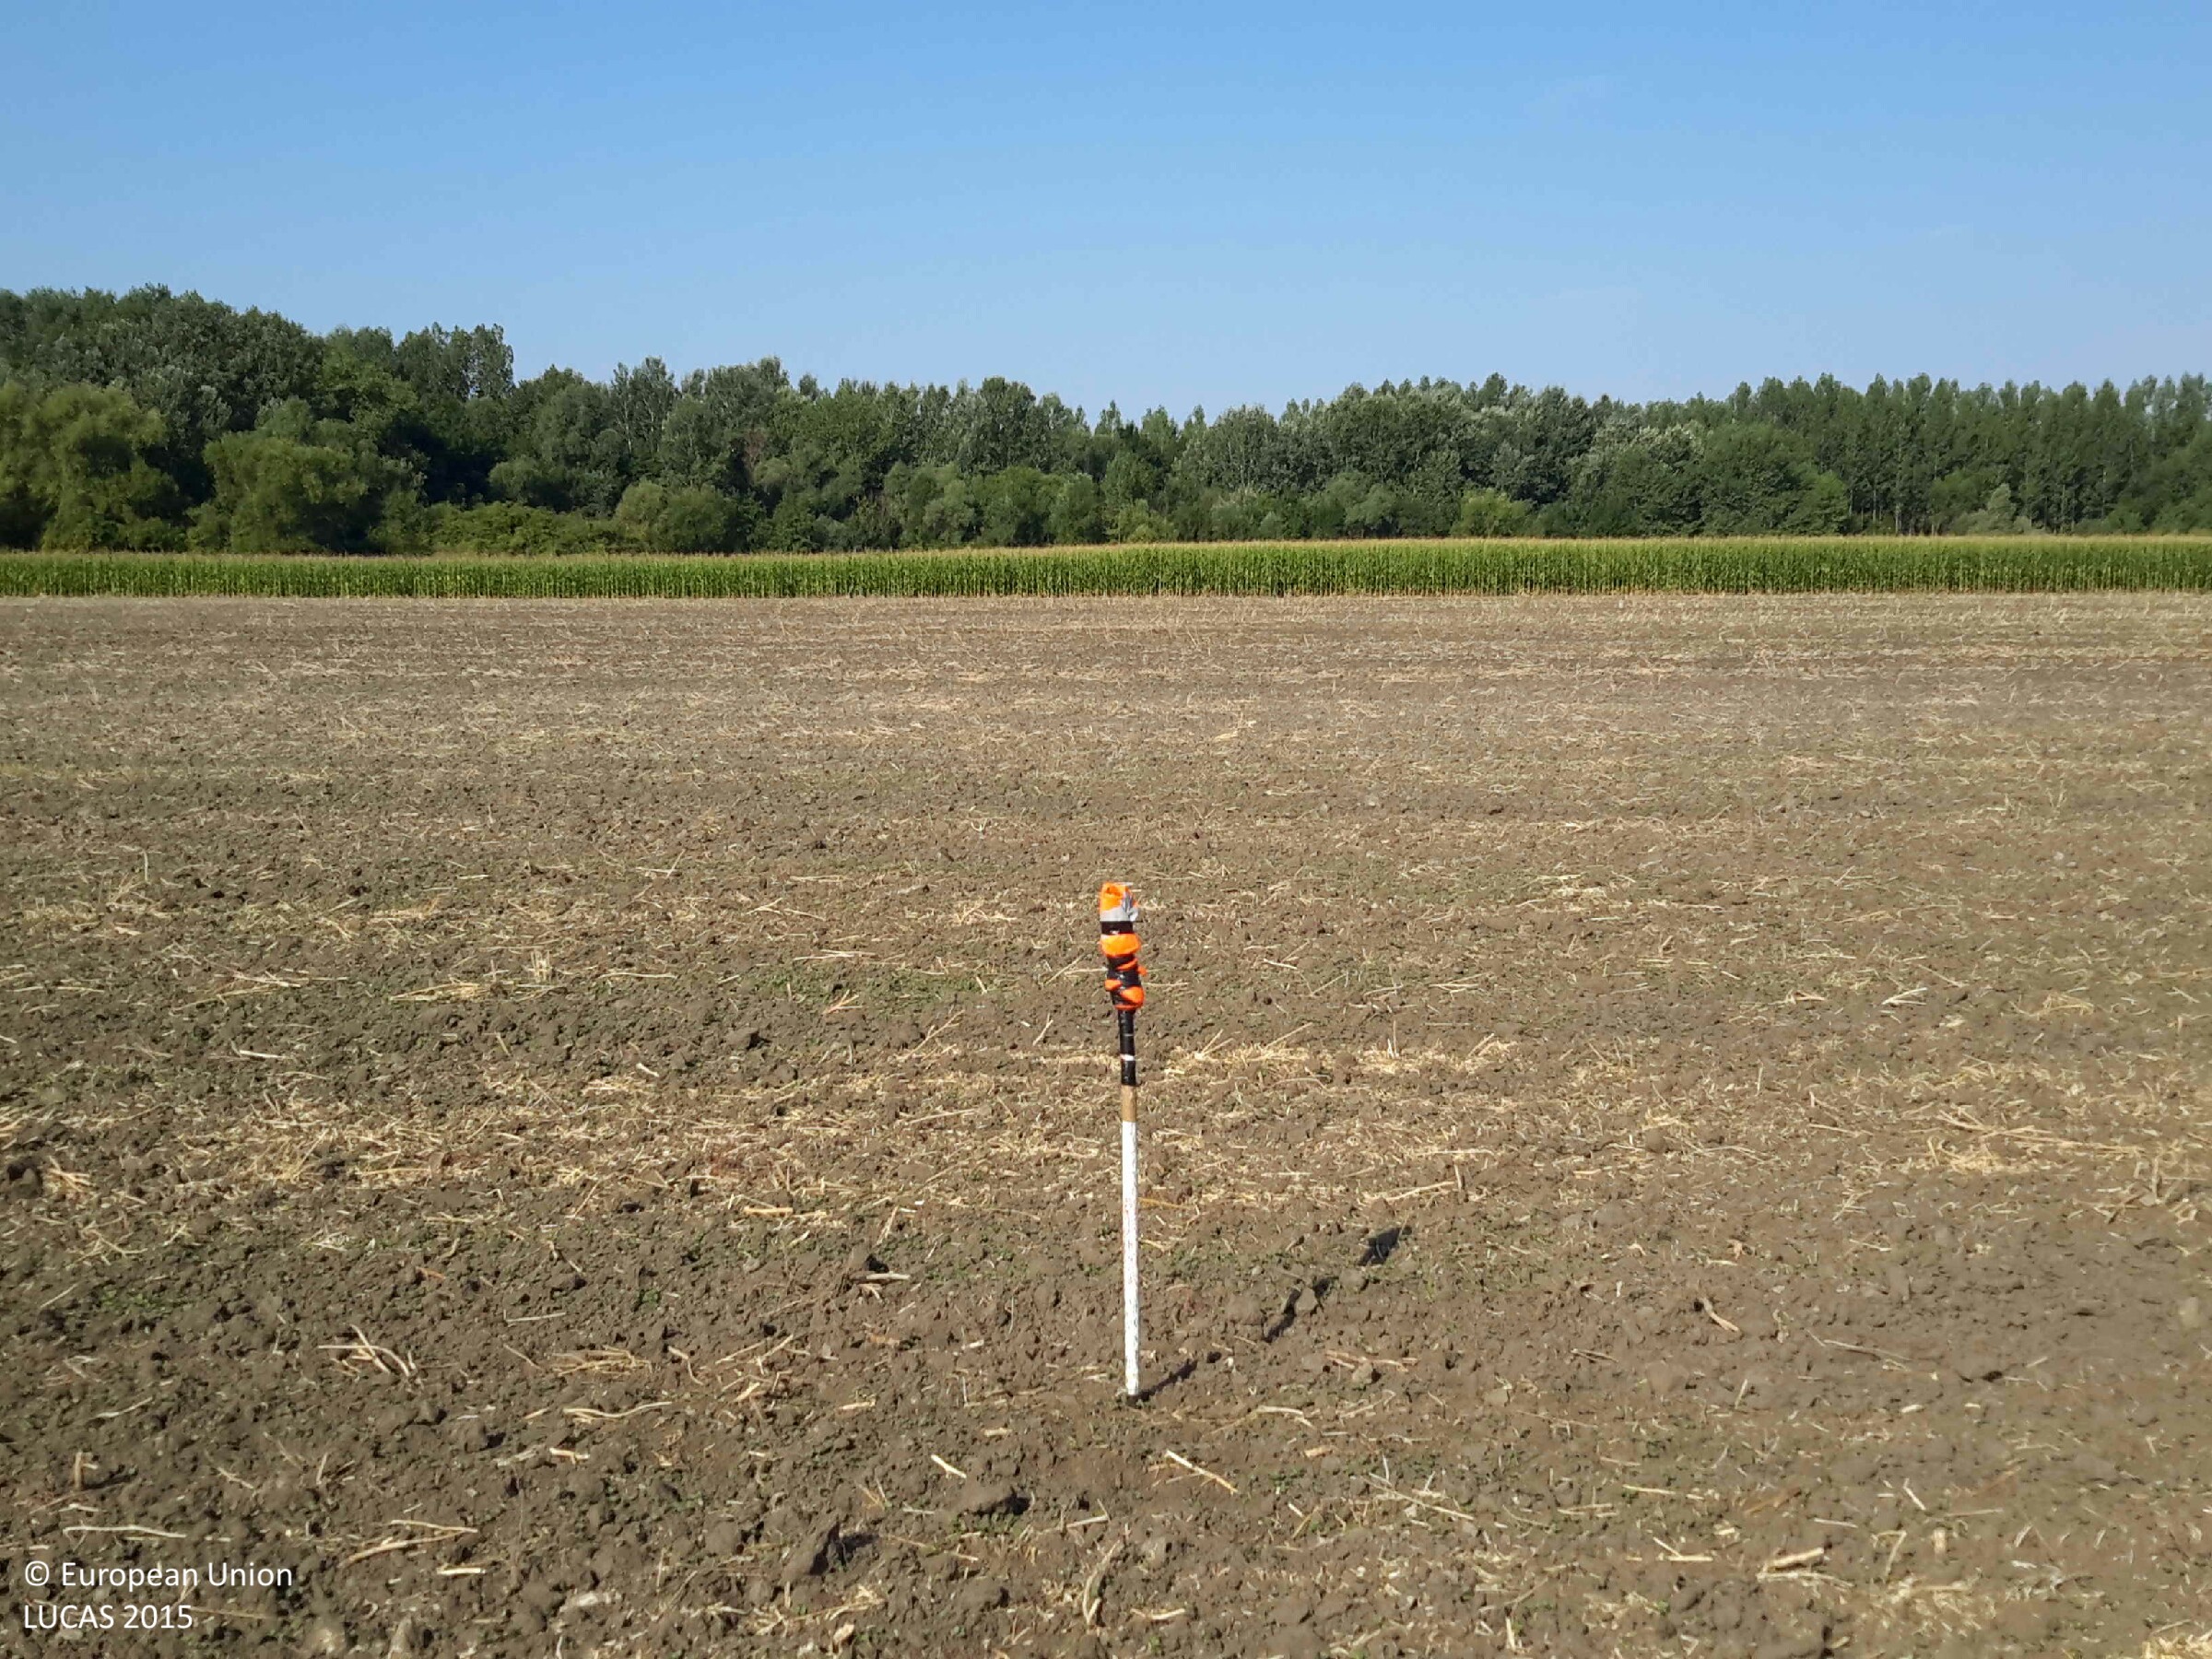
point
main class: Cropland
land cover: Rape and turnip rape
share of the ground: < 10 %
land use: Agriculture (excluding fallow land and kitchen gardens)
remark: Harvested field
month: July
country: HU
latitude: 47.5268
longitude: 17.8597
